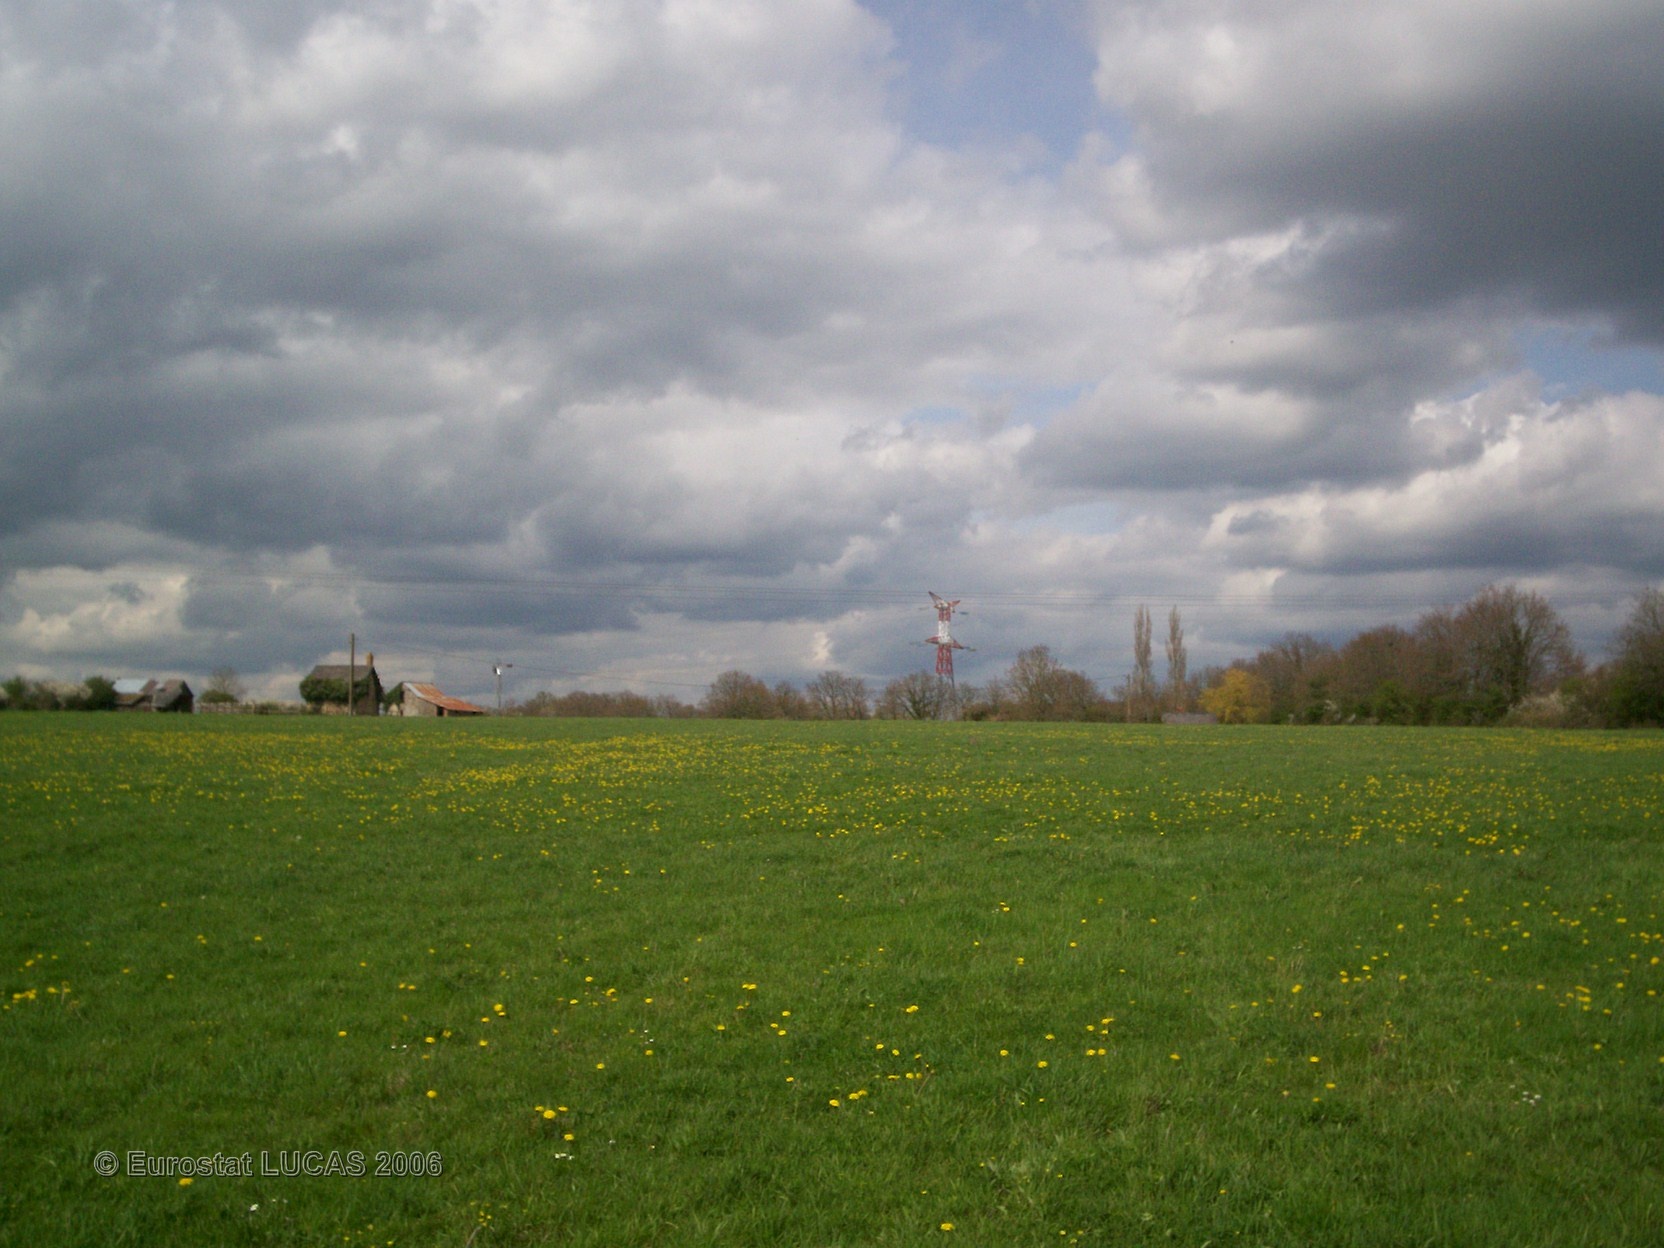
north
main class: Grassland
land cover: Grassland without tree/shrub cover
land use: Agriculture (excluding fallow land and kitchen gardens)
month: April
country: FR
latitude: 47.9116
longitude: -0.5904
